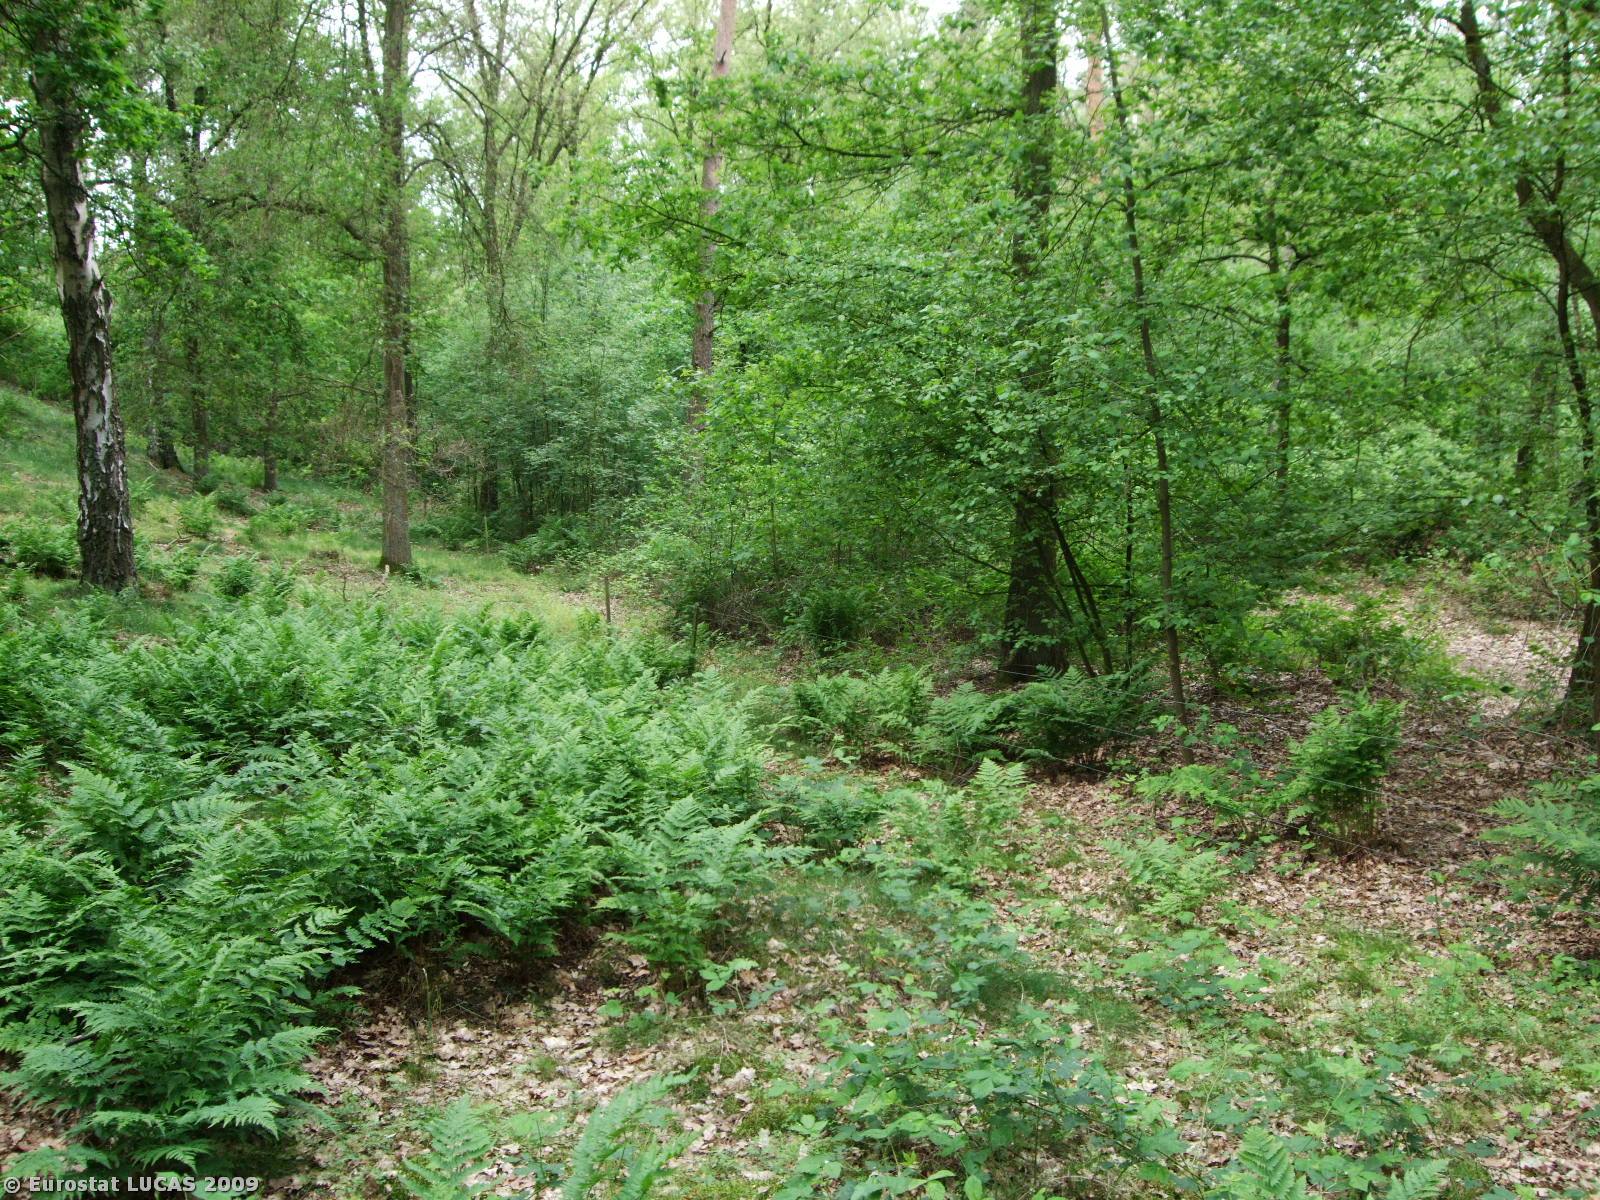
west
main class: Woodland
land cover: Mixed woodland
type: mesophytic deciduous forest
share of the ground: > 75 %
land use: Nature reserves
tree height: > 5 m
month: May
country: NL
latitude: 51.5063
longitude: 6.1812
